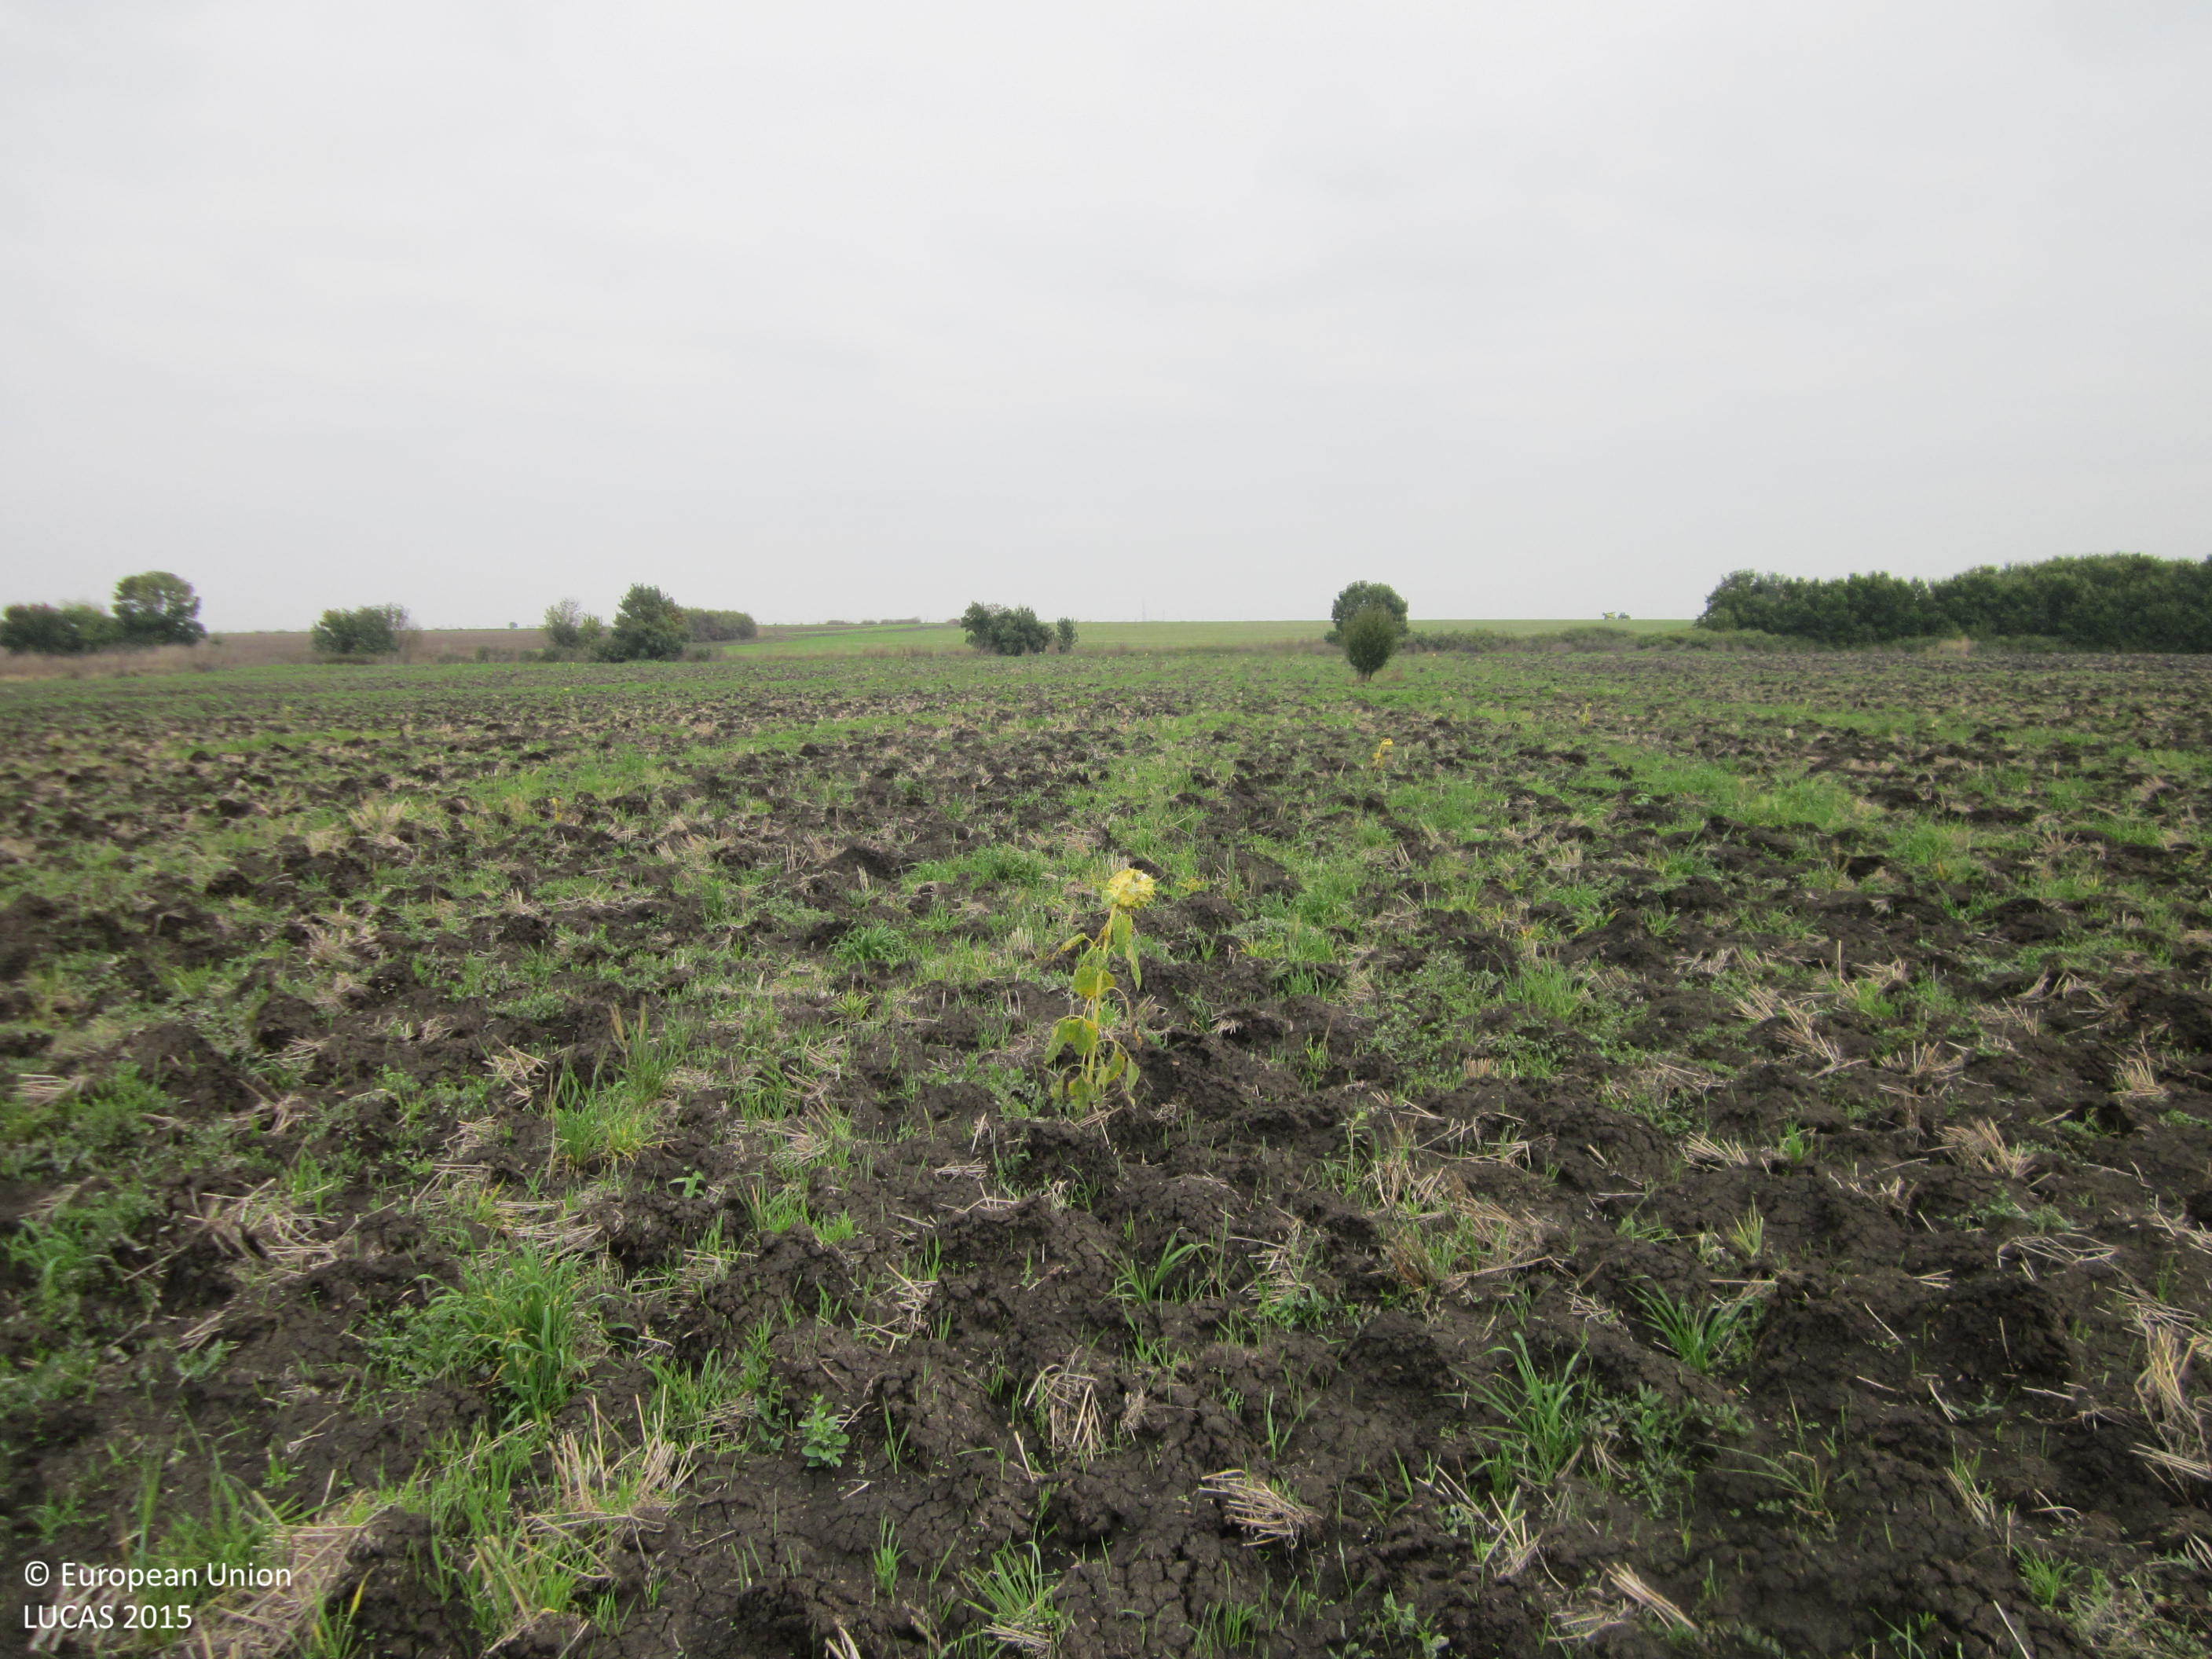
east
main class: Cropland
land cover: Barley
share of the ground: < 10 %
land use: Agriculture (excluding fallow land and kitchen gardens)
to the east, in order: Barley; Grass margins; Ditches and canals; Grass margins; Common wheat
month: October
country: BG
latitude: 42.5476
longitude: 27.2208
